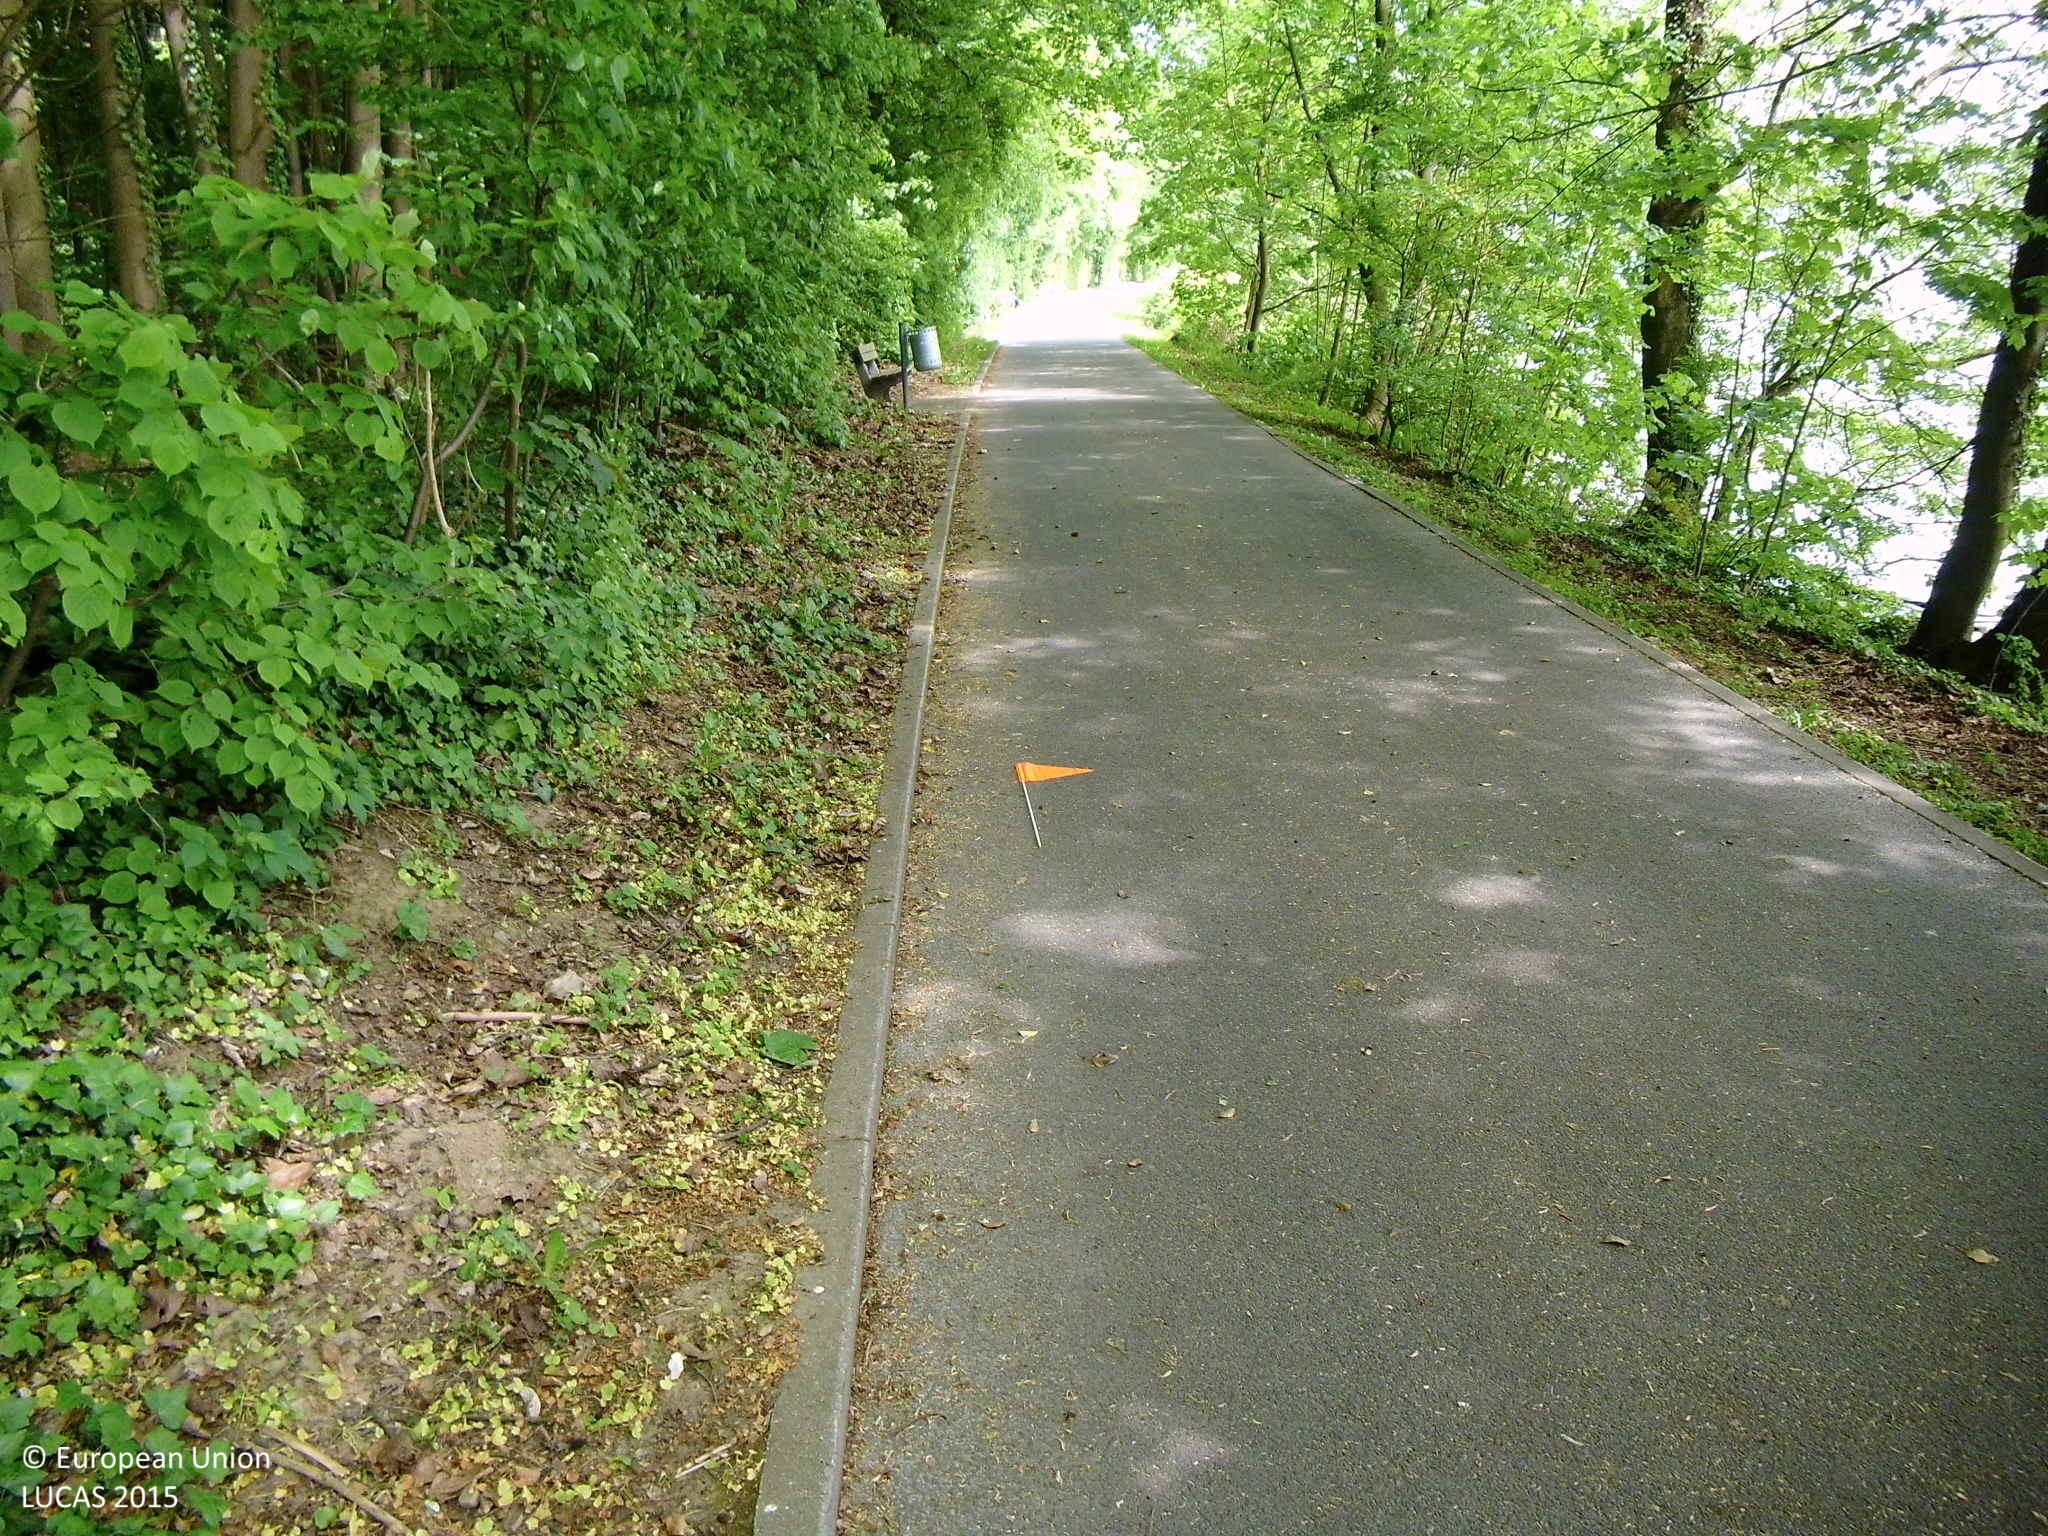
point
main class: Woodland
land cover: Broadleaved woodland
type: beech forest
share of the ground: > 75 %
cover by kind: broadleaved forest trees 100 %
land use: Forestry
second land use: Amenities, museums, leisure
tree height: > 5 m
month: May
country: DE
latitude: 51.3958
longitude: 7.3987
